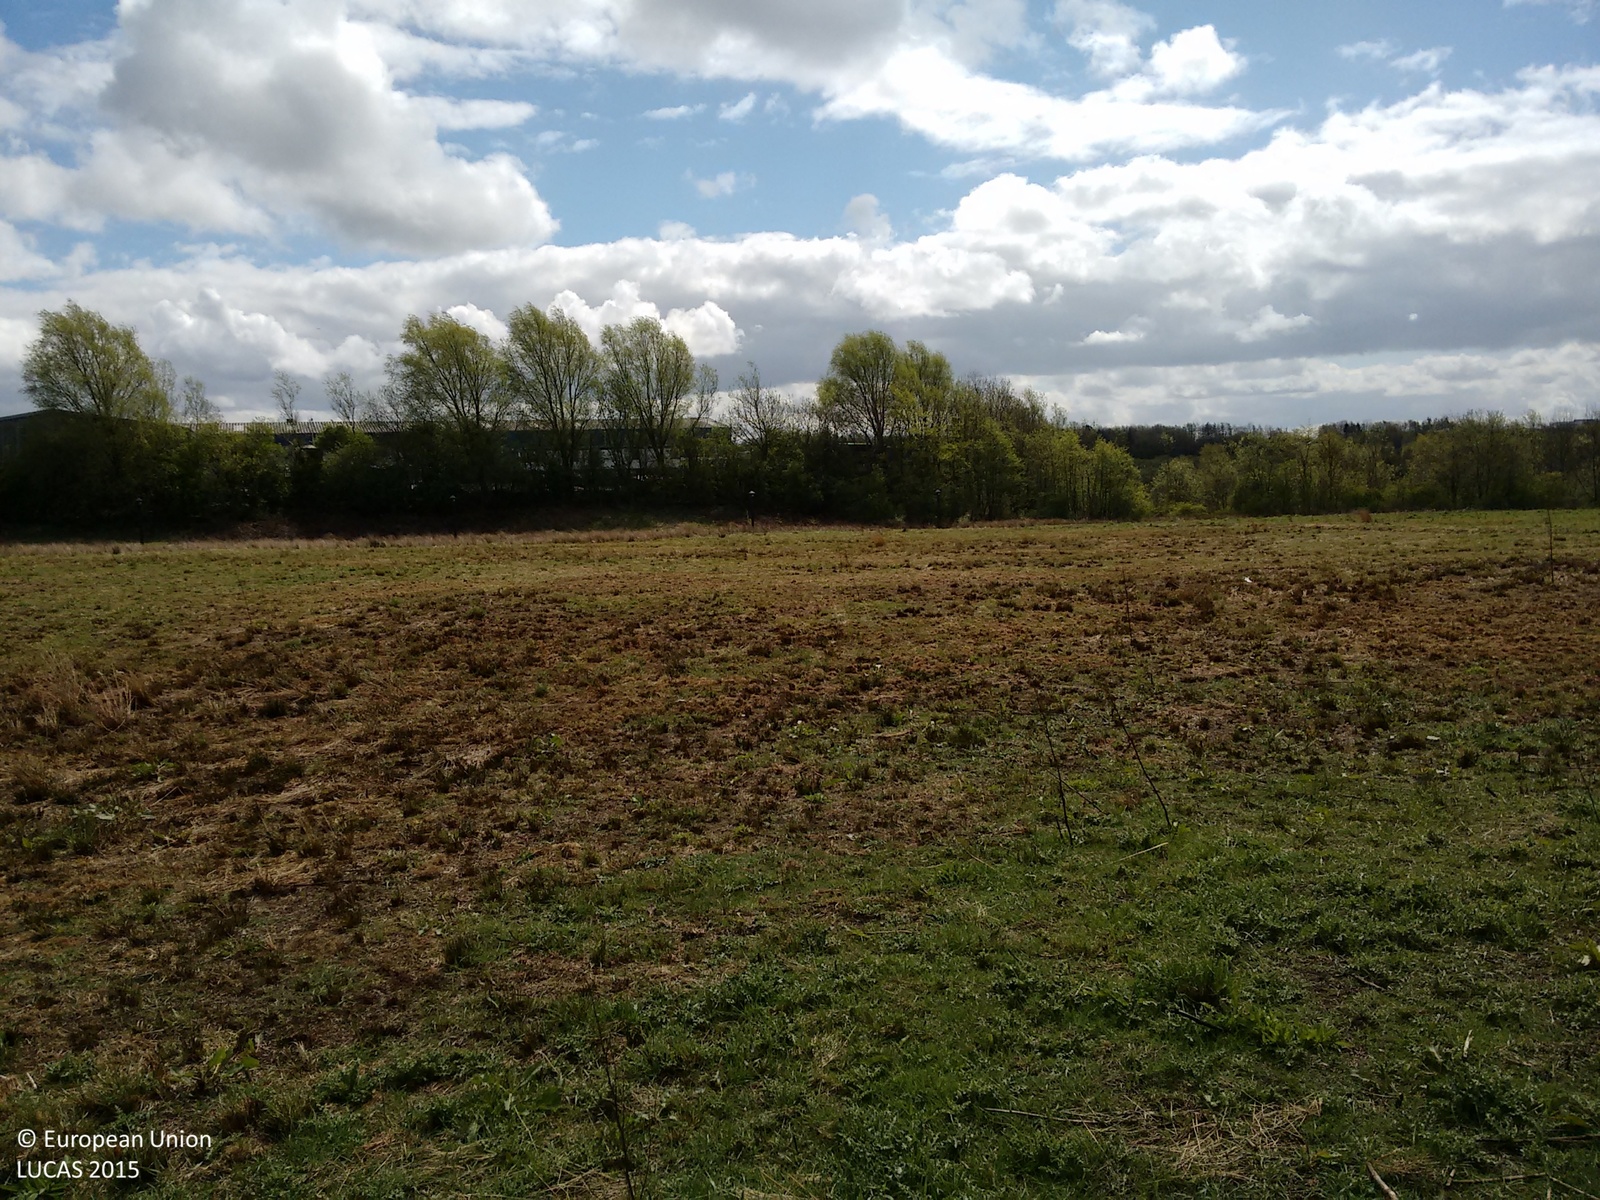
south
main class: Grassland
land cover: Grassland without tree/shrub cover
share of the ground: > 75 %
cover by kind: herbaceous plants 95 %, unconsolidated bare surface 5 %
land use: Amenities, museums, leisure
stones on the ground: < 10 %
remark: Burnt area
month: May
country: GB
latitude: 55.8570
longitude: -3.9701
